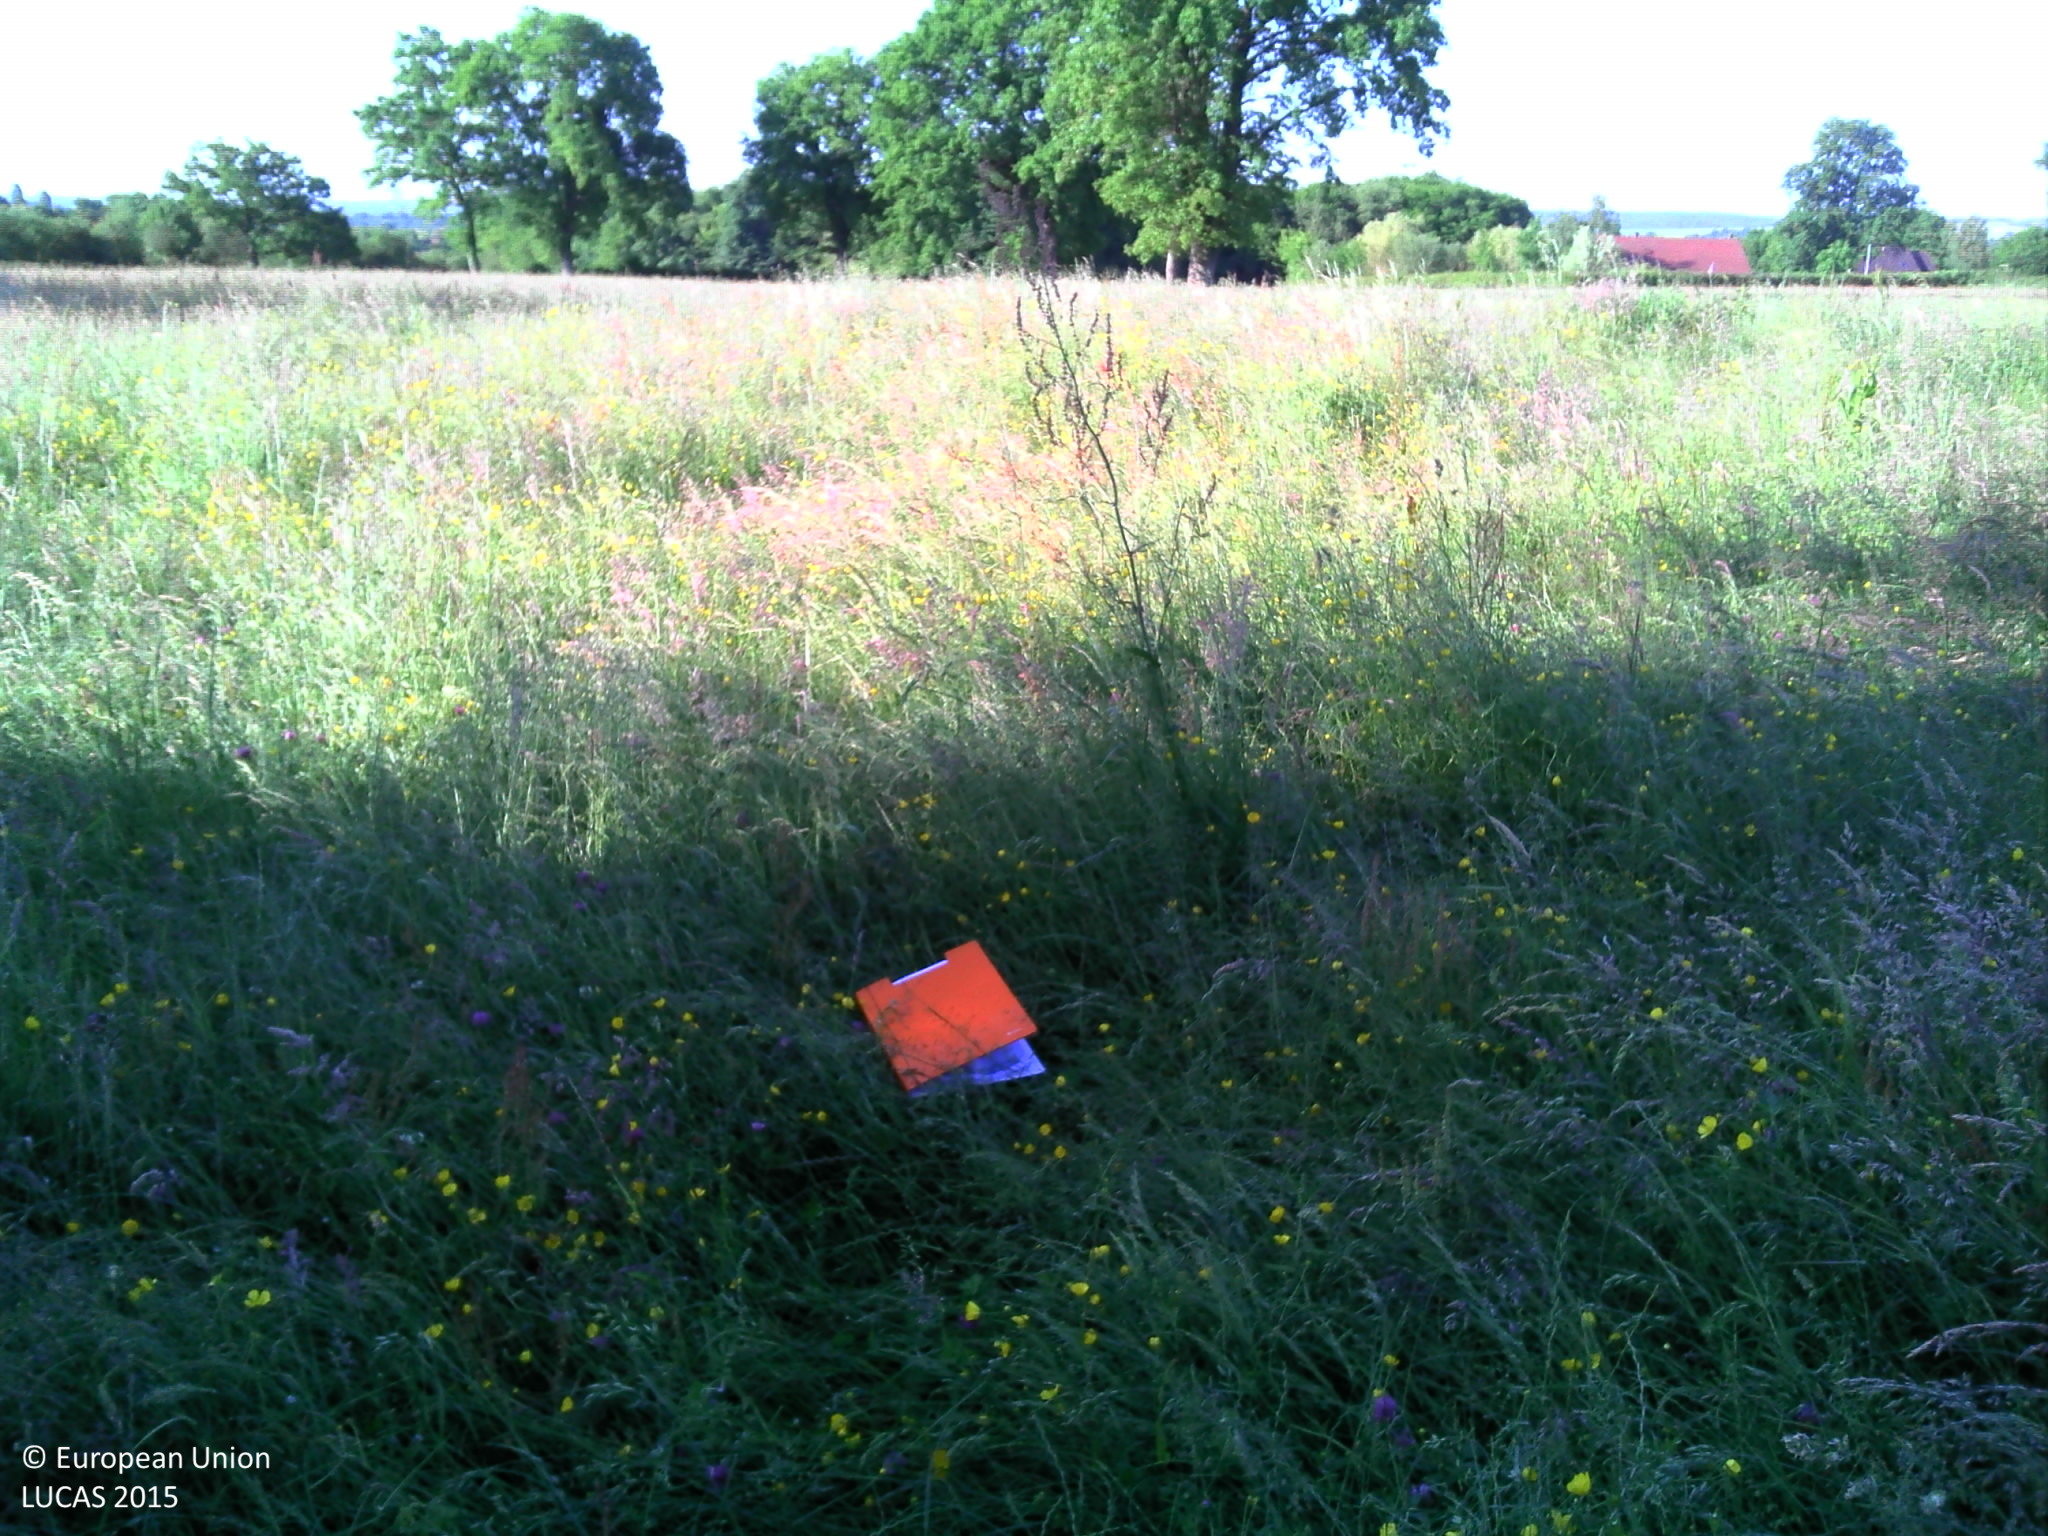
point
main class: Grassland
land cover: Grassland with sparse tree/shrub cover
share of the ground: > 75 %
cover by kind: herbaceous plants 95 %, broadleaved forest trees 5 %
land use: Agriculture (excluding fallow land and kitchen gardens)
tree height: > 5 m
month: May
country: FR
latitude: 47.4328
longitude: 2.8742
